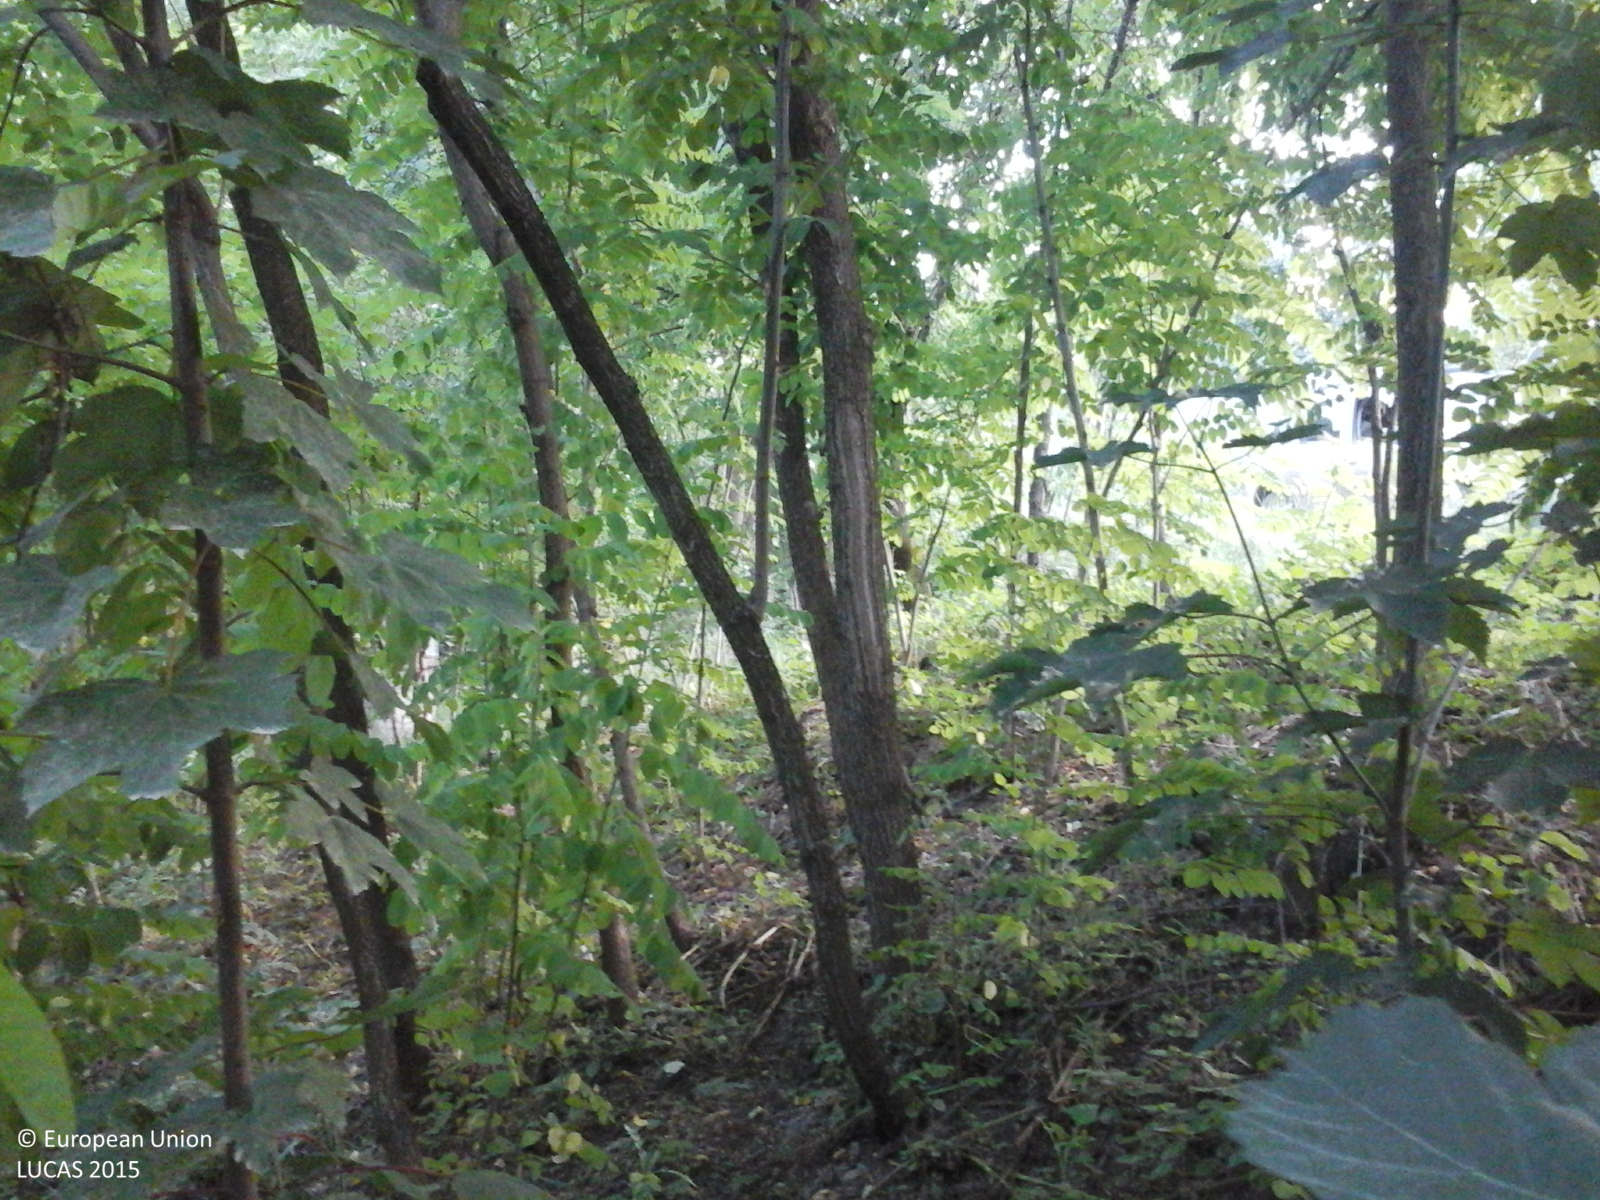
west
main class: Woodland
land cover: Broadleaved woodland
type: floodplain forest
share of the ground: > 75 %
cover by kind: broadleaved forest trees 100 %
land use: Semi-natural and natural areas not in use
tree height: > 5 m
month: June
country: RO
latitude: 47.5172
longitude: 26.5162
